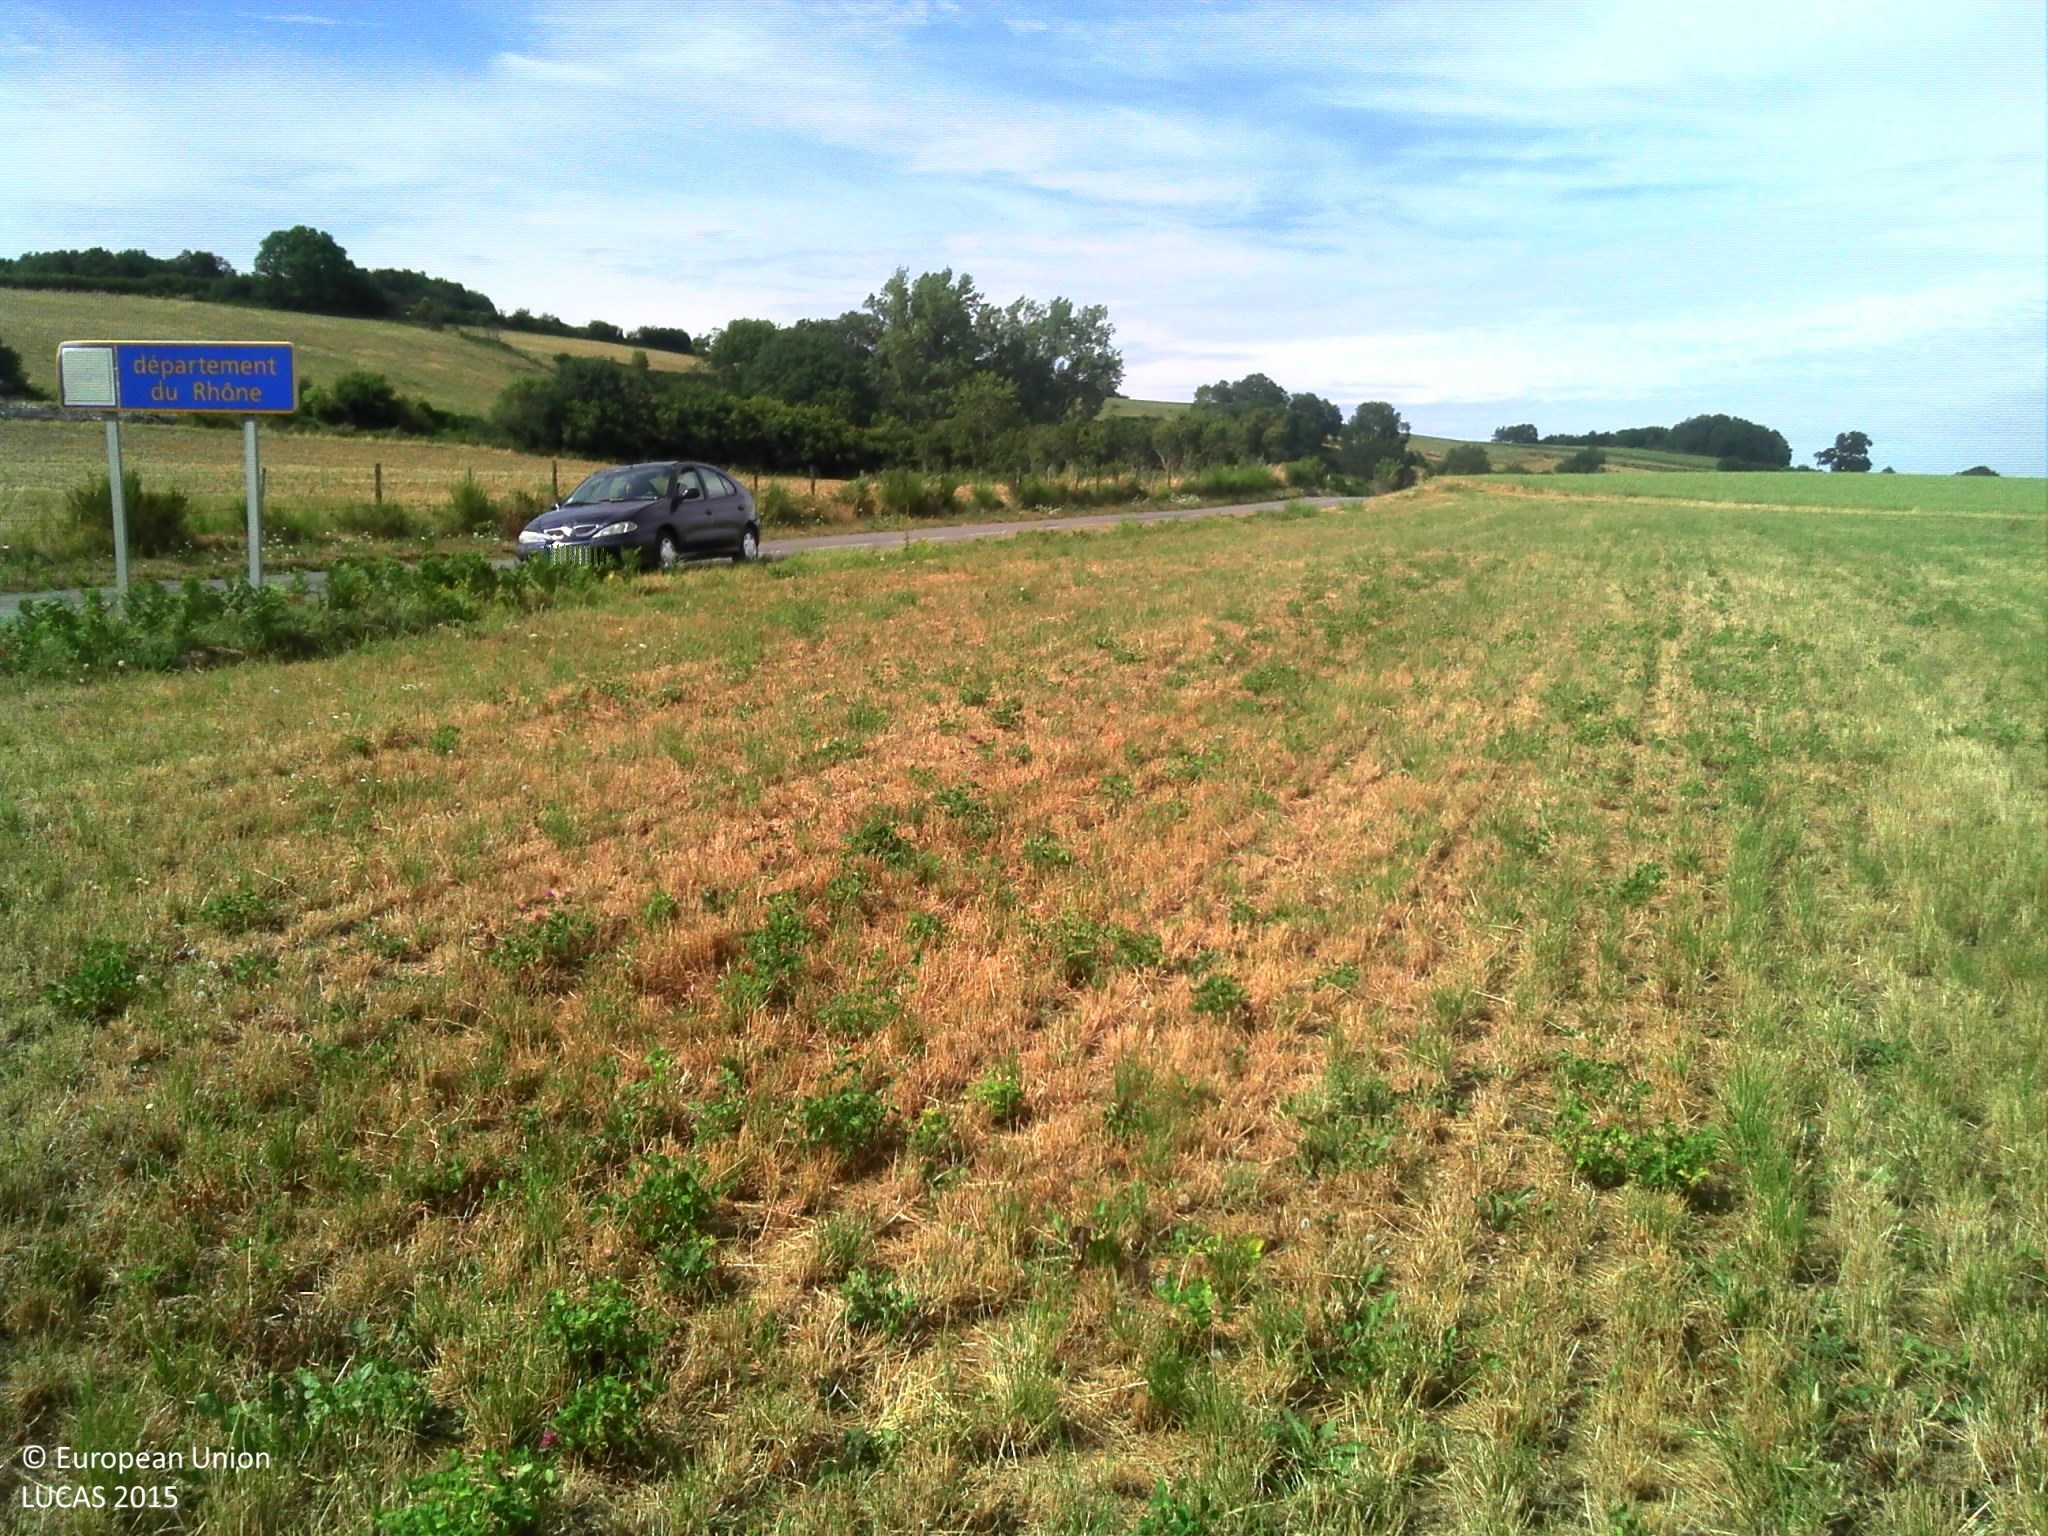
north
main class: Cropland
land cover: Temporary grasslands
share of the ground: > 75 %
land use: Agriculture (excluding fallow land and kitchen gardens)
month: July
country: FR
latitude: 45.5781
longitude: 4.5058
